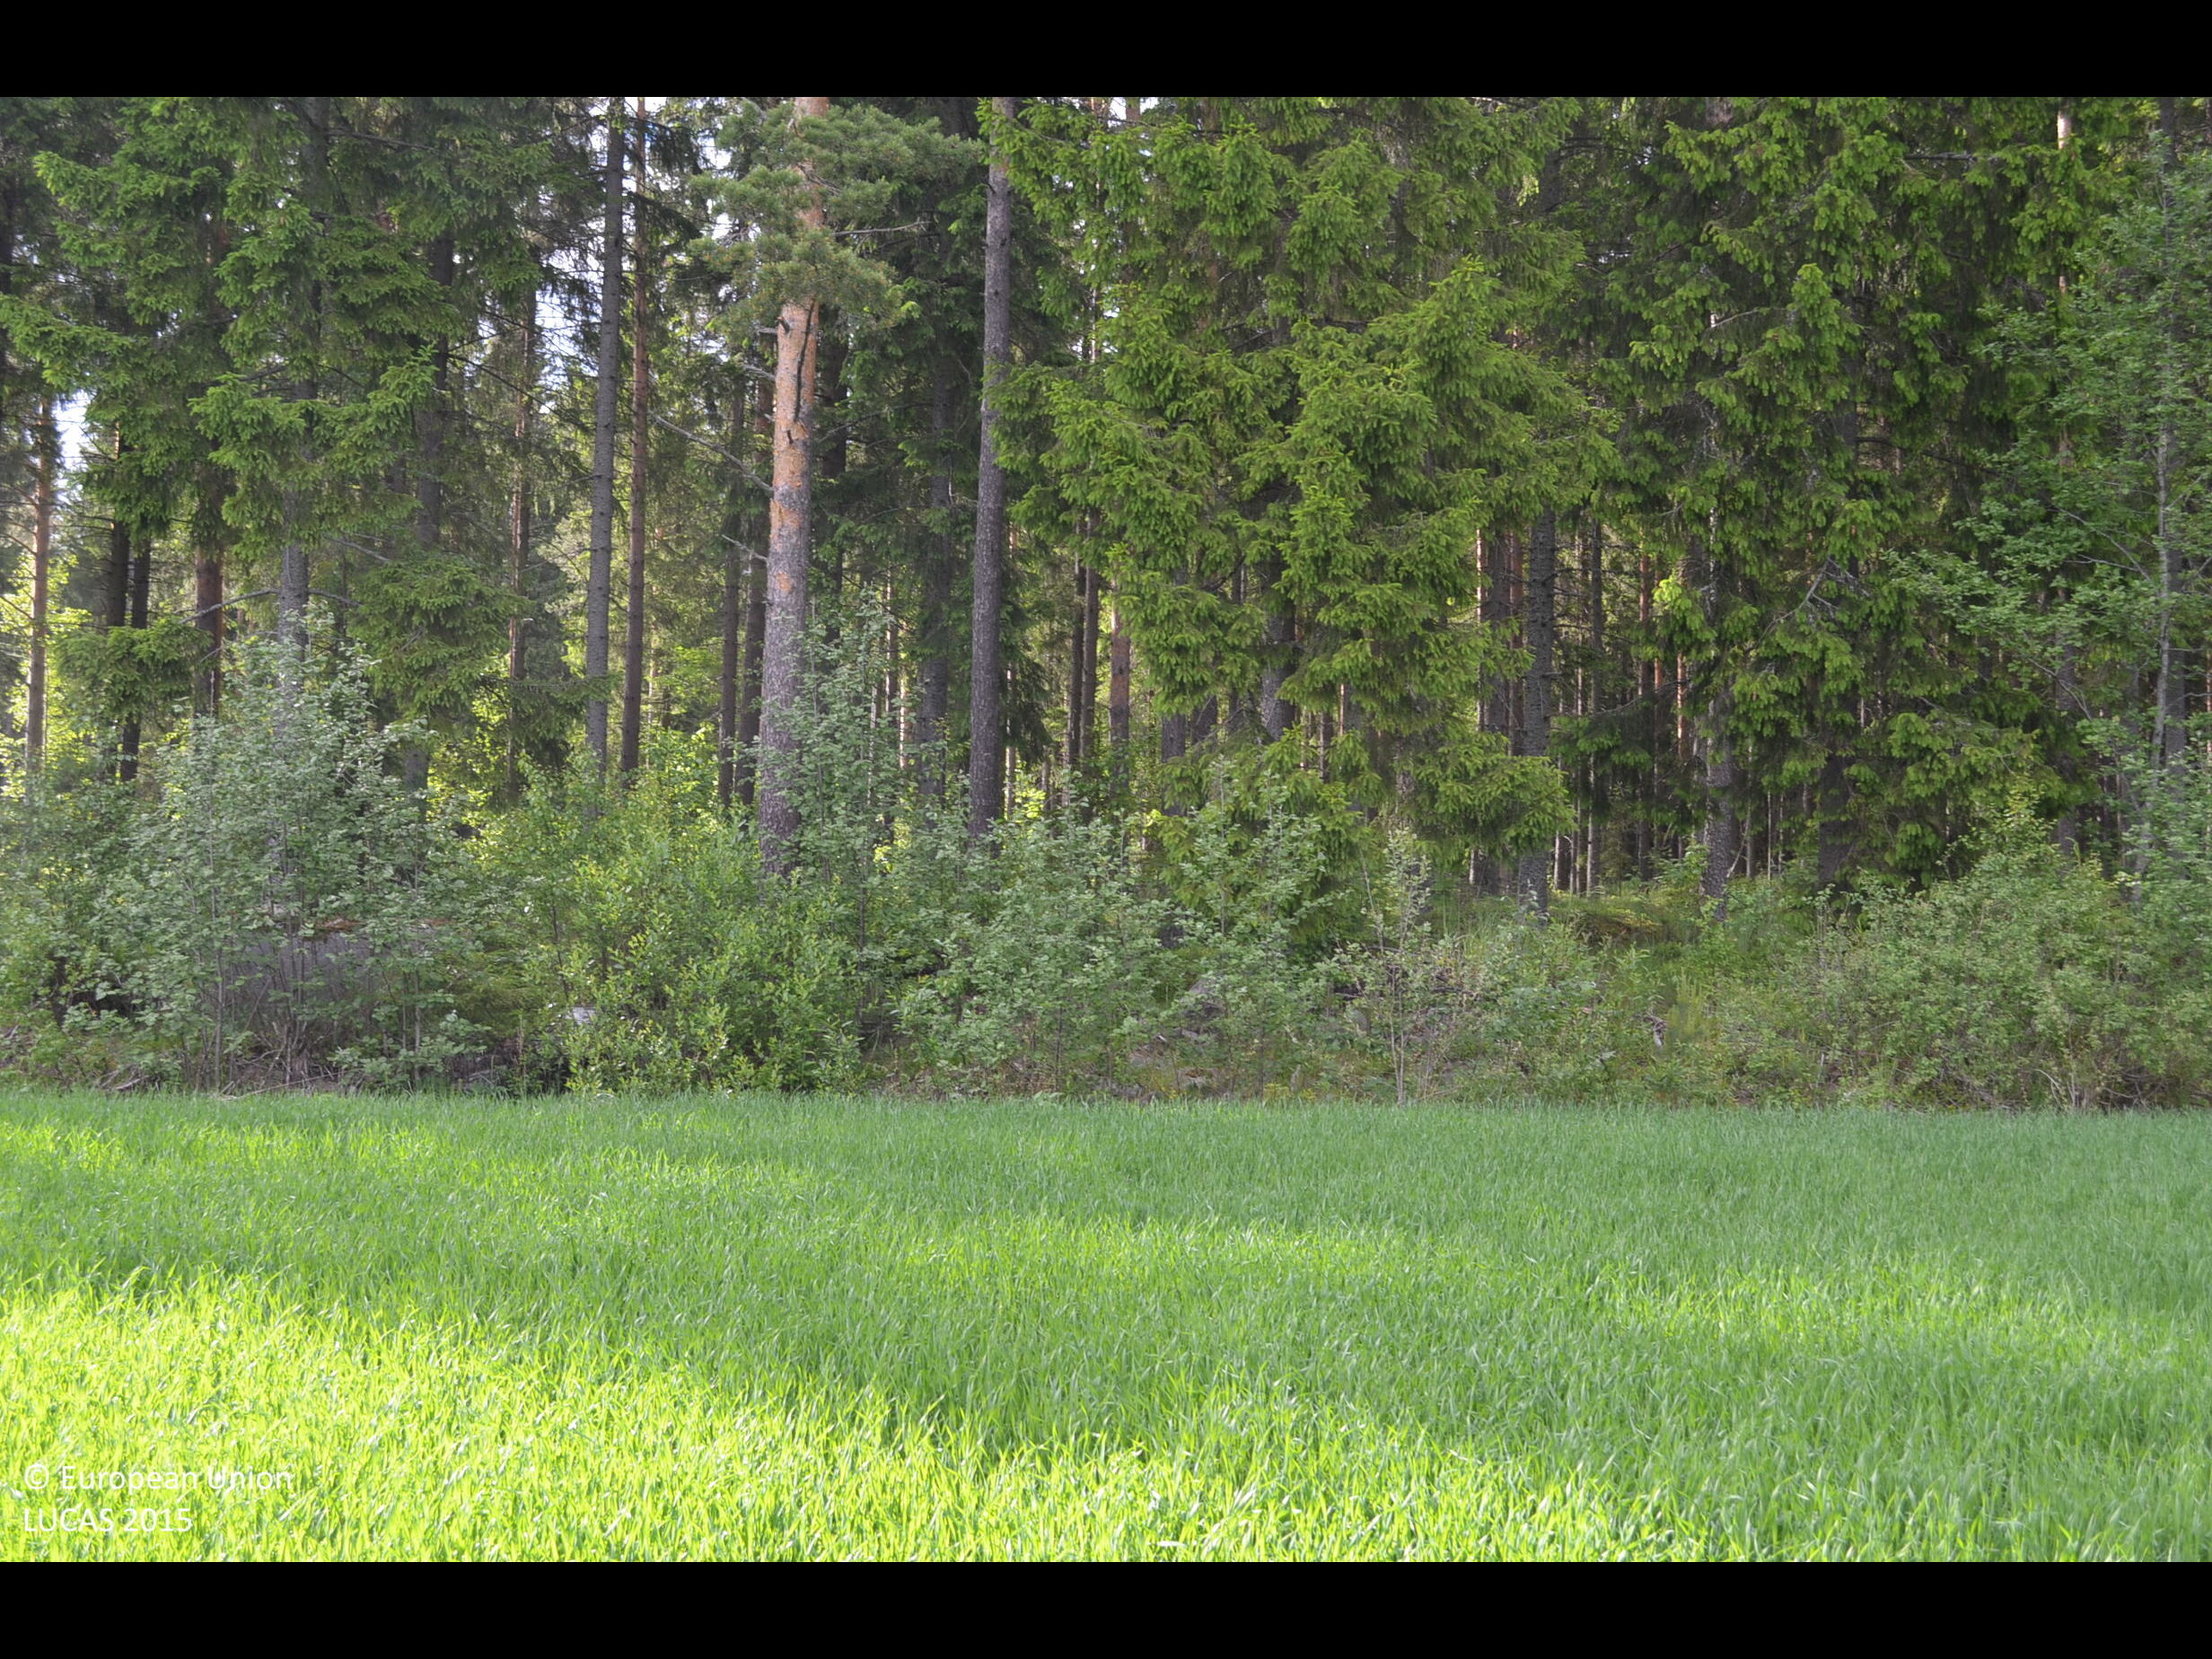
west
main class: Cropland
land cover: Oats
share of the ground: > 75 %
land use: Agriculture (excluding fallow land and kitchen gardens)
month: June
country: FI
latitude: 61.8171
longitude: 23.3026
